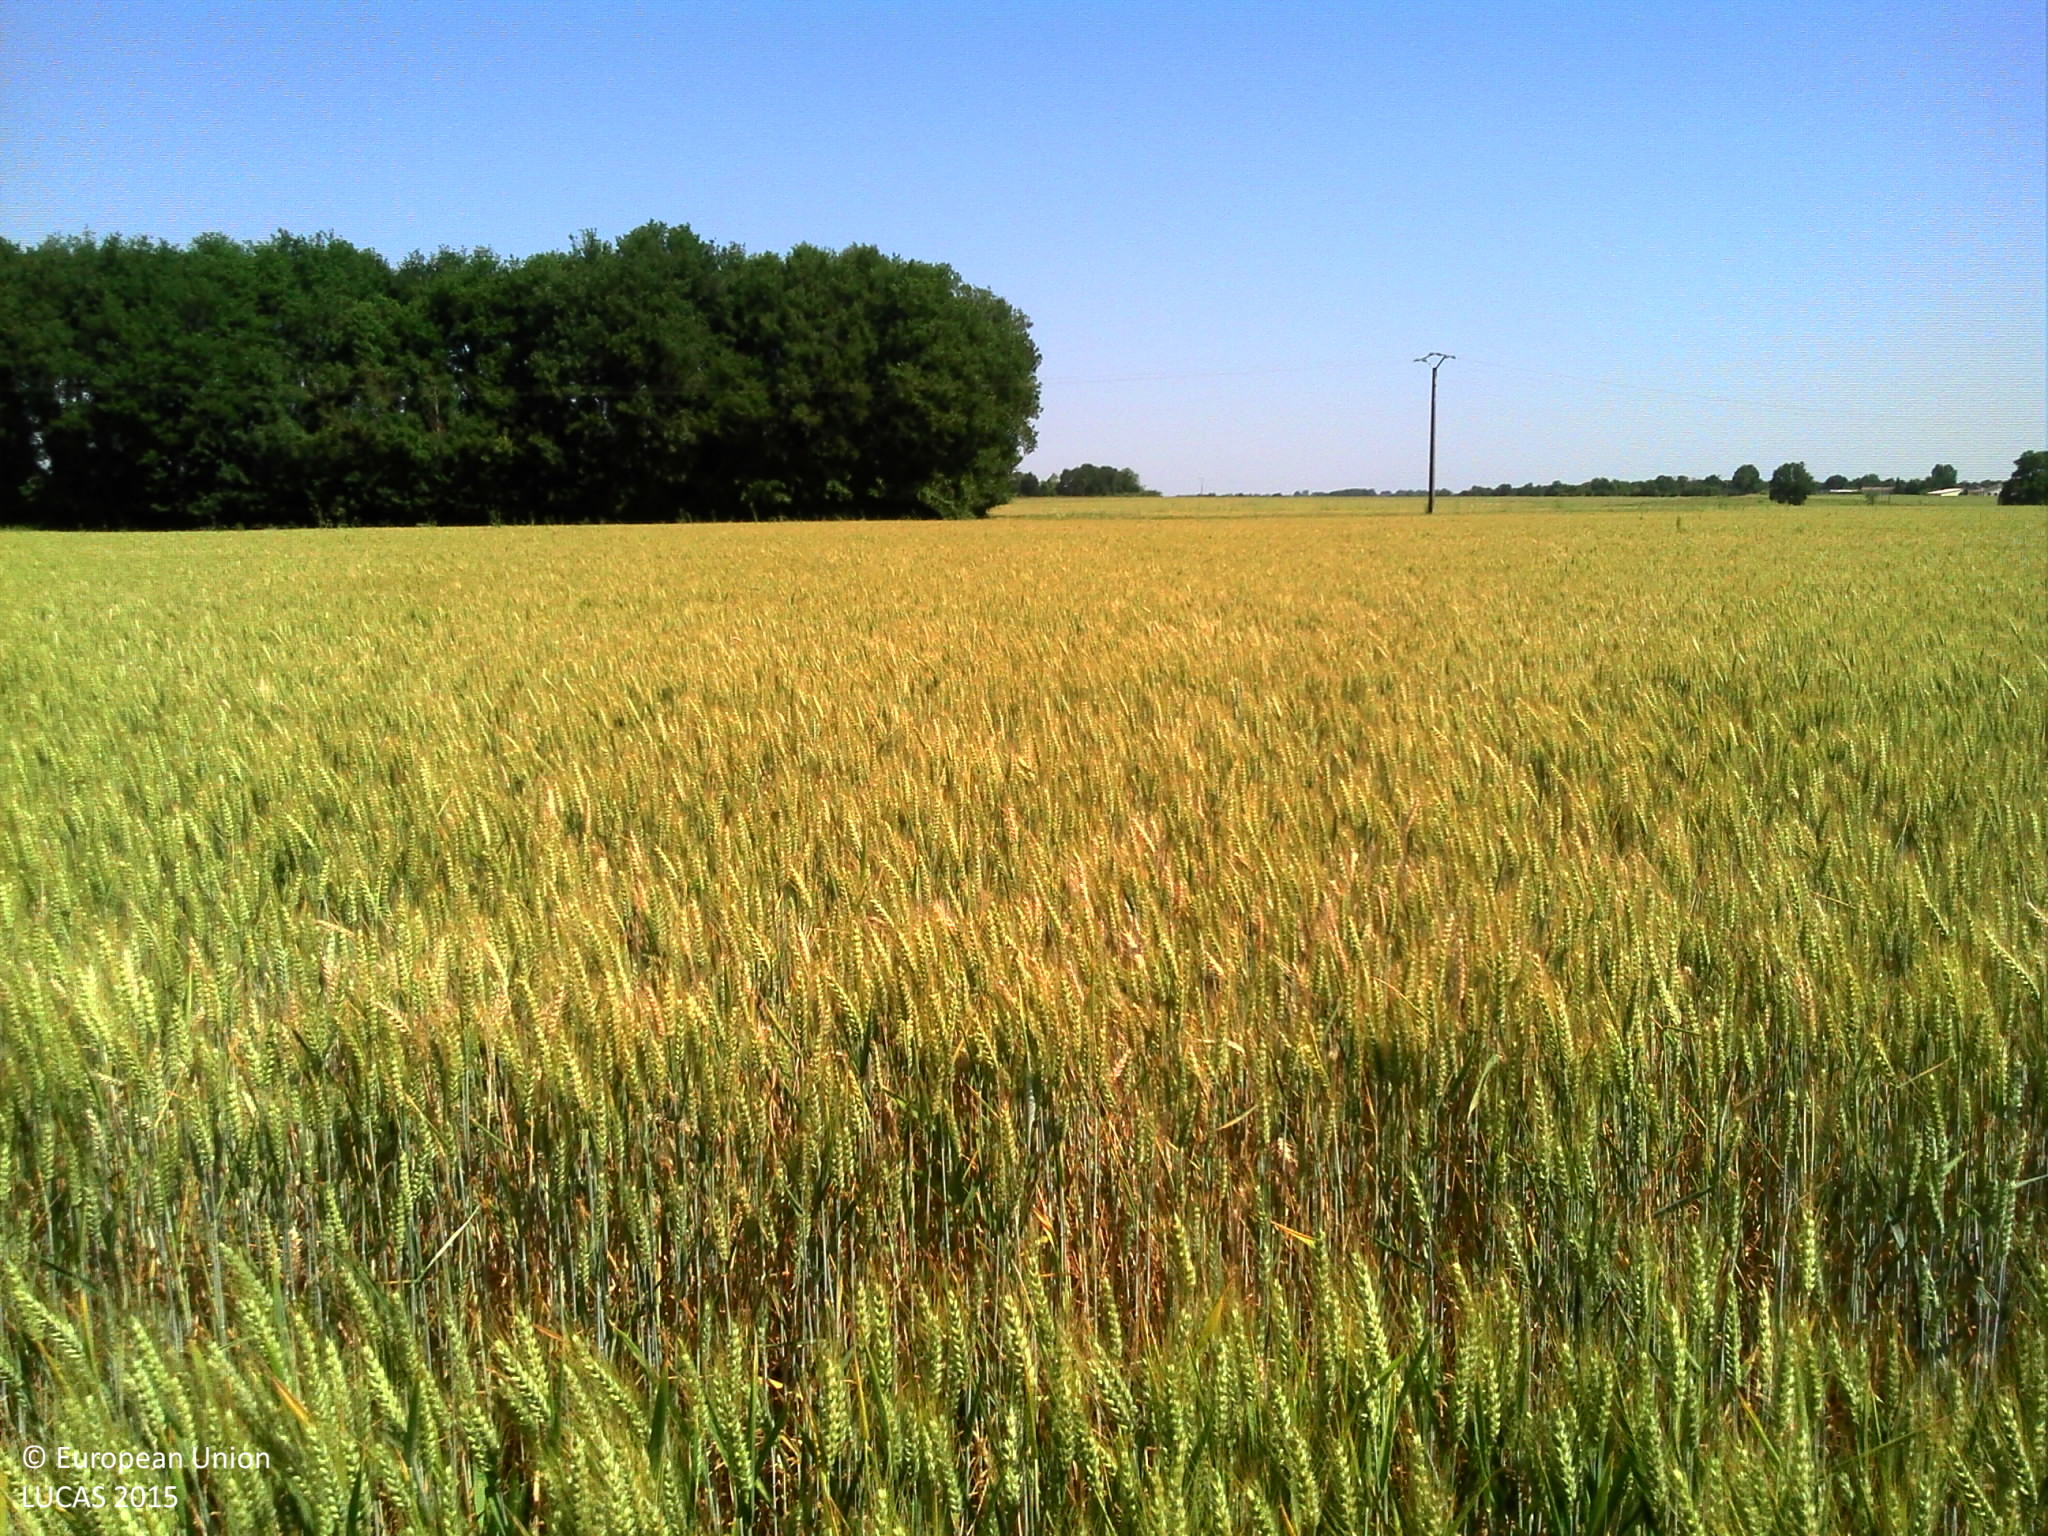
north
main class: Cropland
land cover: Common wheat
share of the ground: > 75 %
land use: Agriculture (excluding fallow land and kitchen gardens)
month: June
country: FR
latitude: 46.6135
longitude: 0.6735
